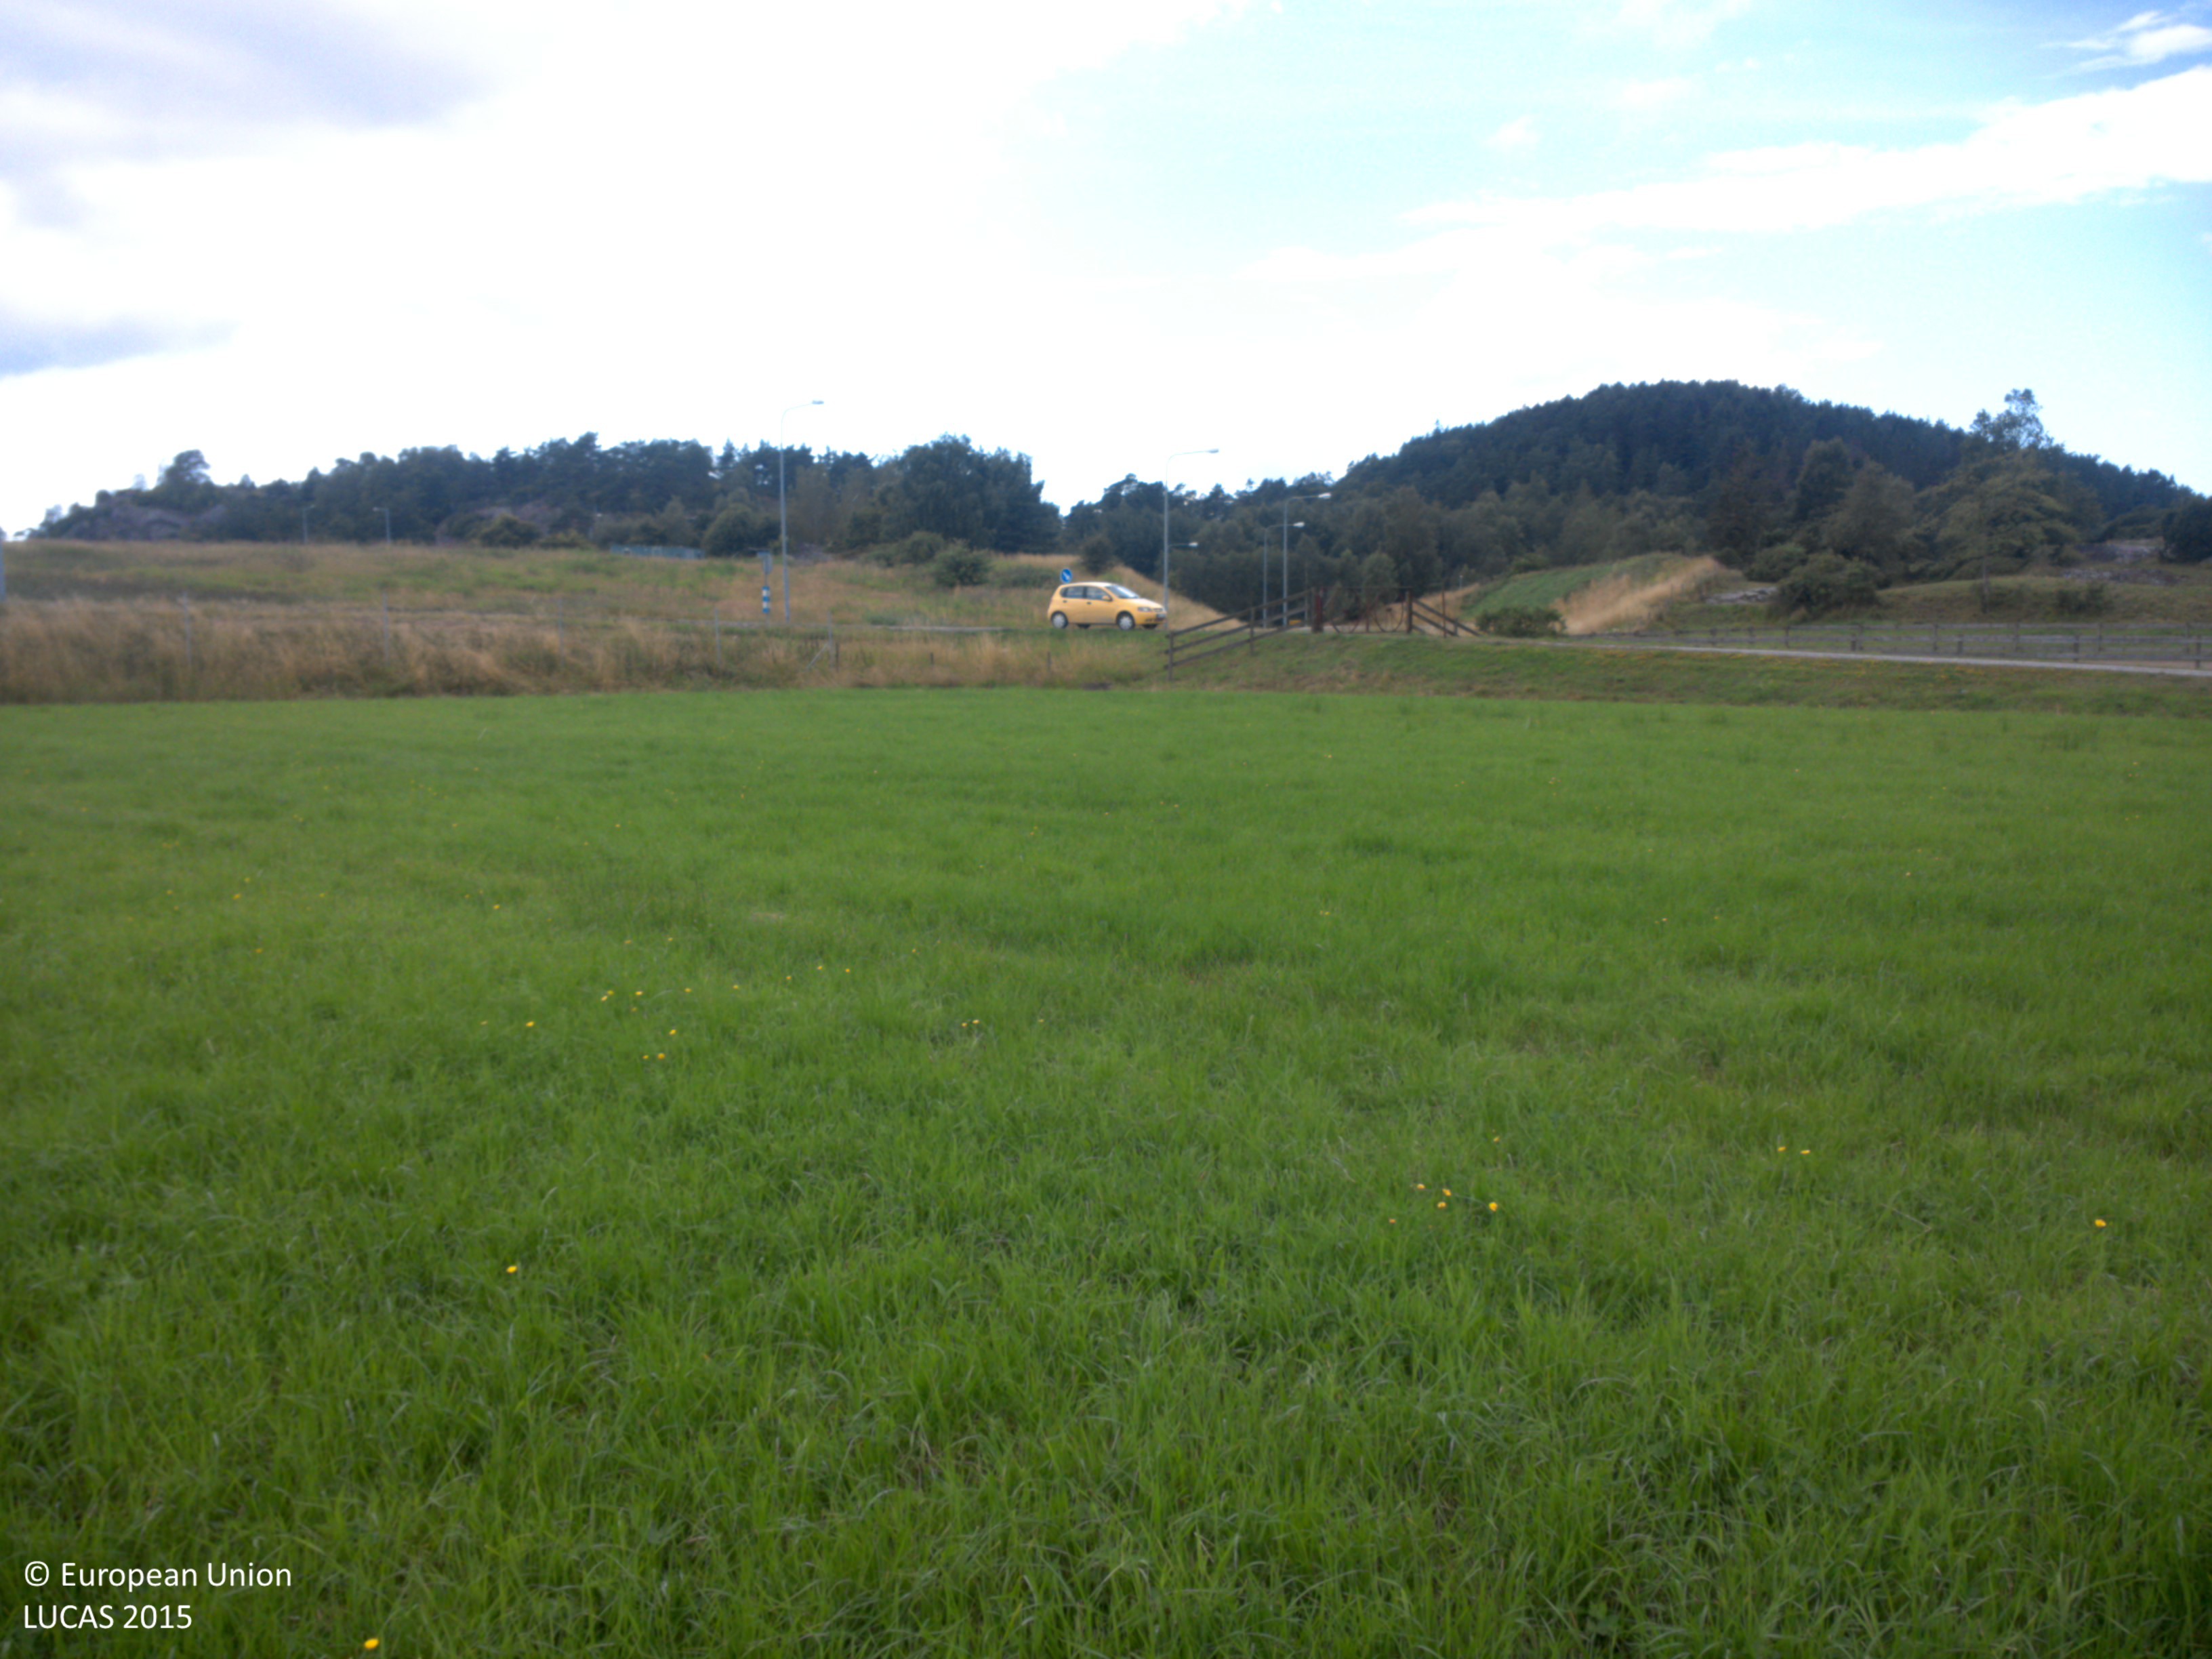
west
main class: Grassland
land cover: Grassland without tree/shrub cover
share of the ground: > 75 %
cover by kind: herbaceous plants 100 %
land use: Agriculture (excluding fallow land and kitchen gardens)
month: July
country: SE
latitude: 58.0270
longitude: 11.8422
